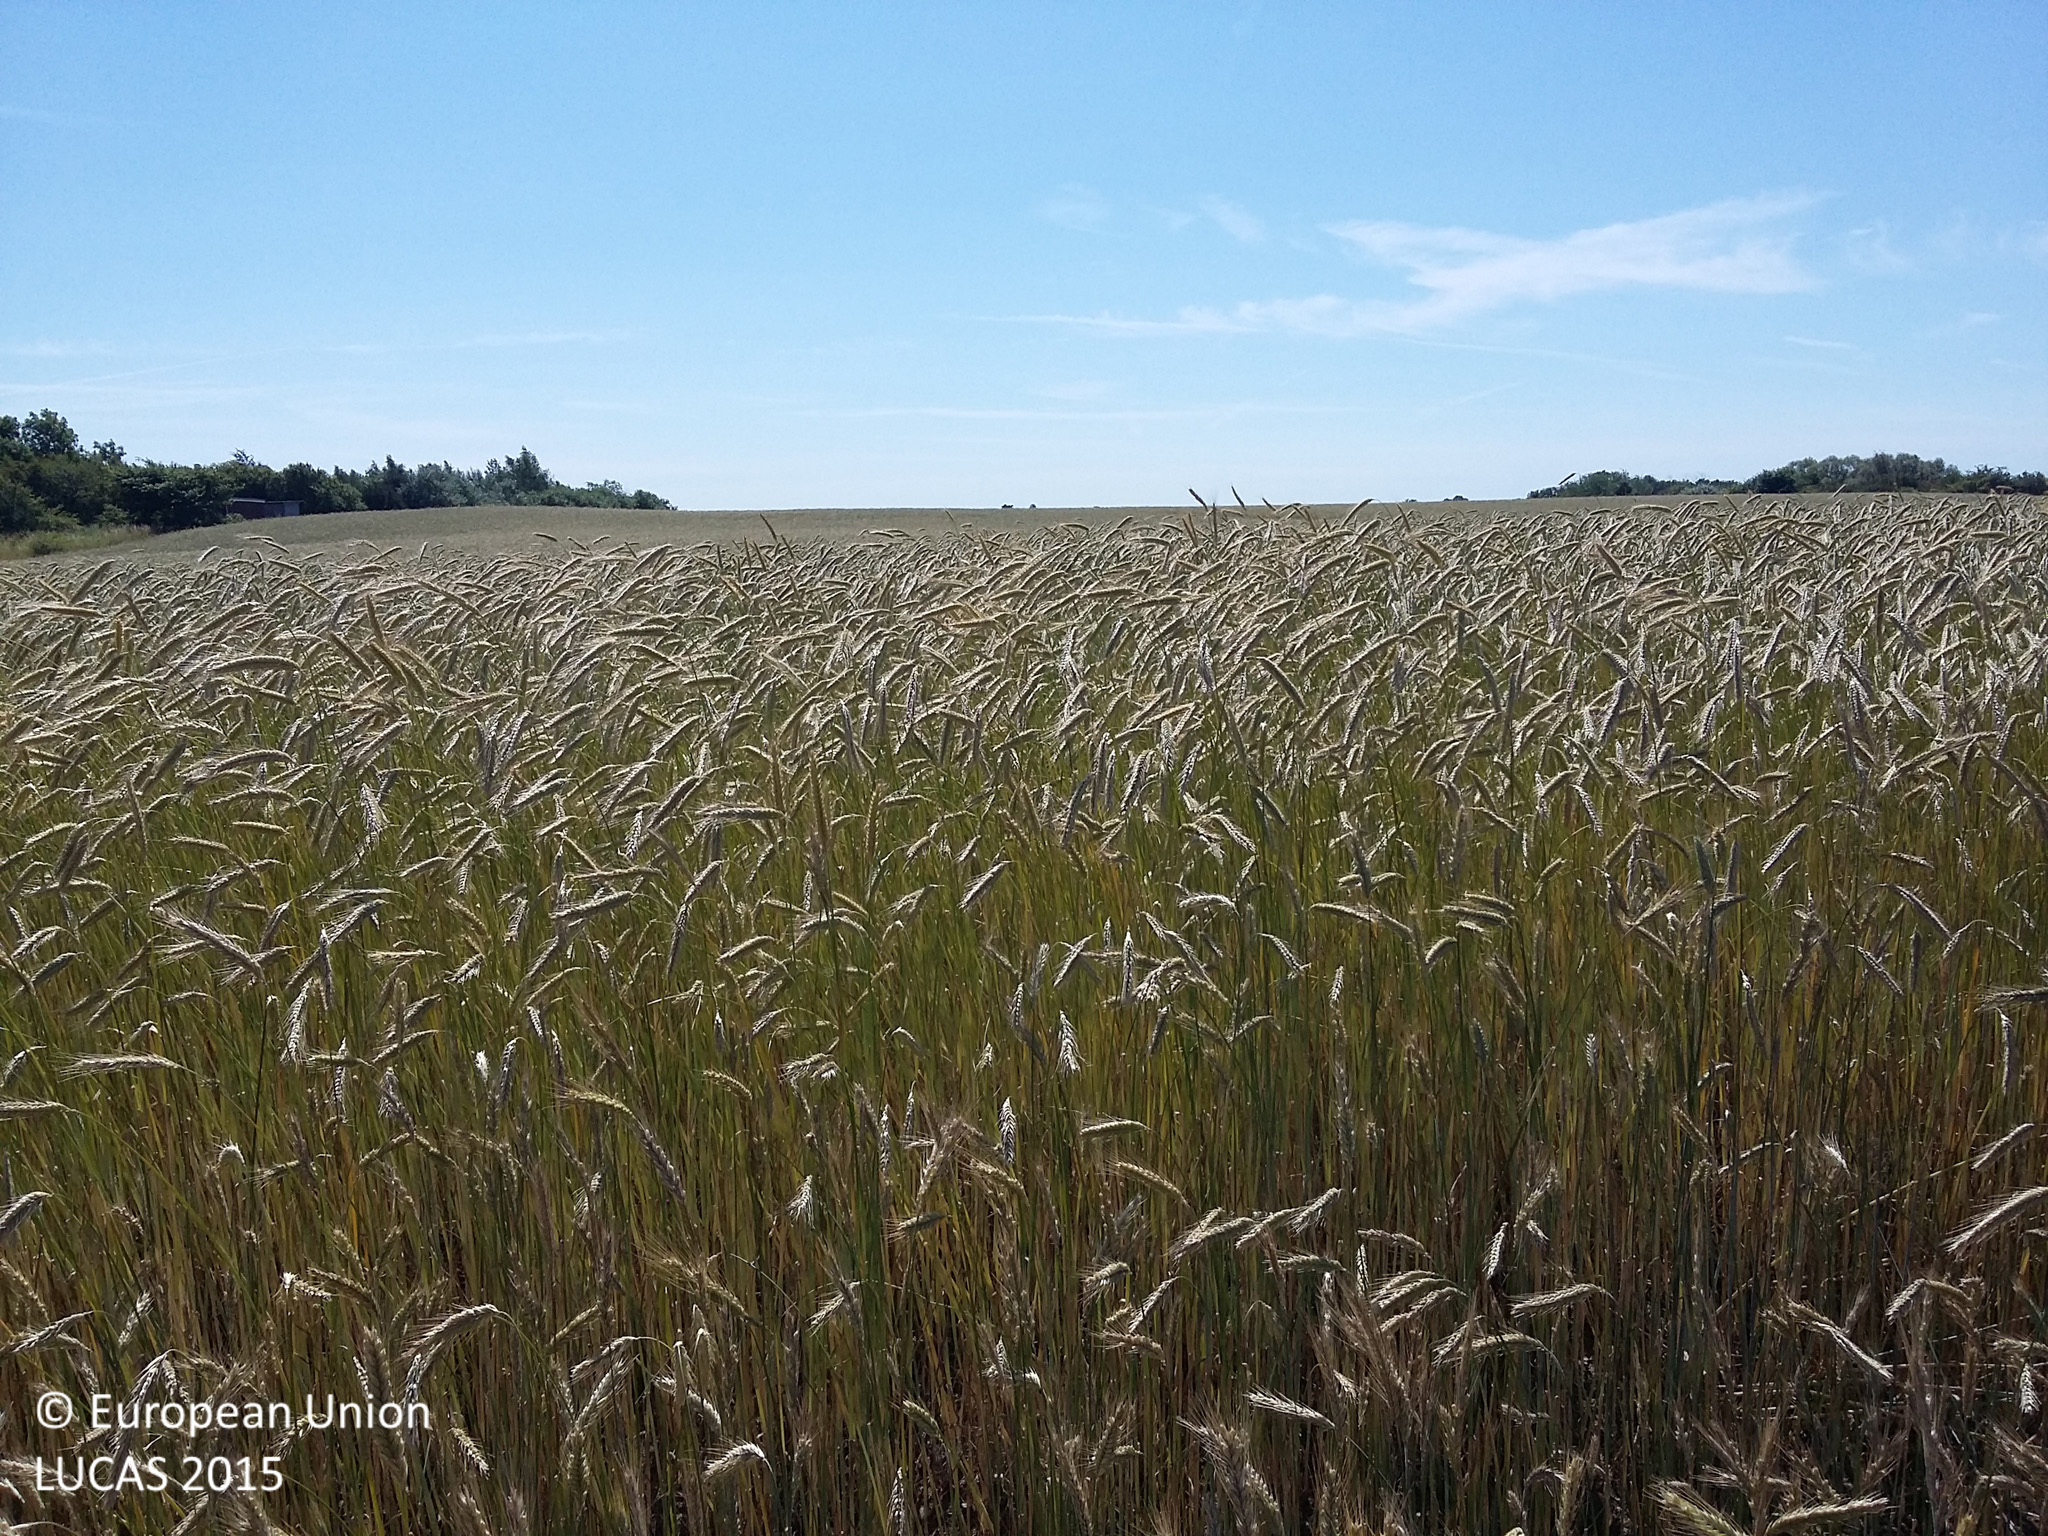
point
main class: Cropland
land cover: Rye
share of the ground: > 75 %
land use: Agriculture (excluding fallow land and kitchen gardens)
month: July
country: DK
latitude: 55.5677
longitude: 11.5051
